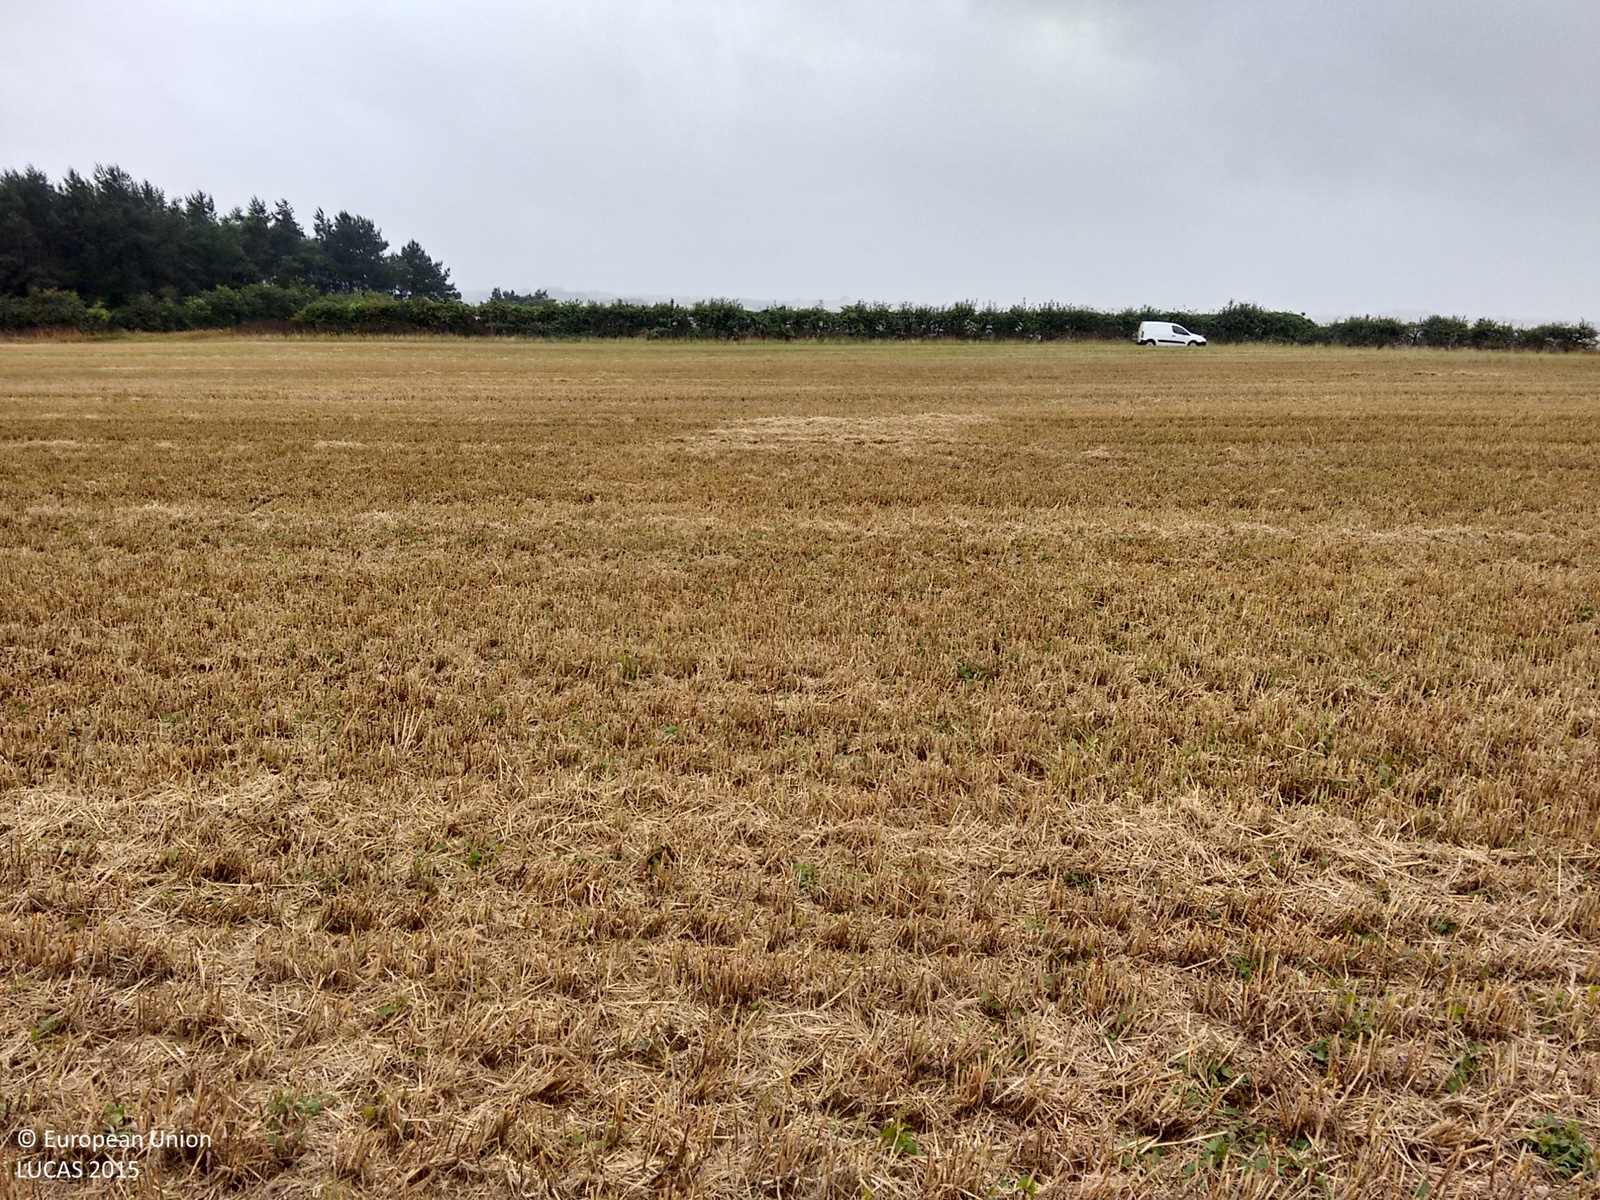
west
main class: Cropland
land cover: Common wheat
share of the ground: > 75 %
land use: Agriculture (excluding fallow land and kitchen gardens)
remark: Harvested field
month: August
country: GB
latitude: 52.9220
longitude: 0.7684
